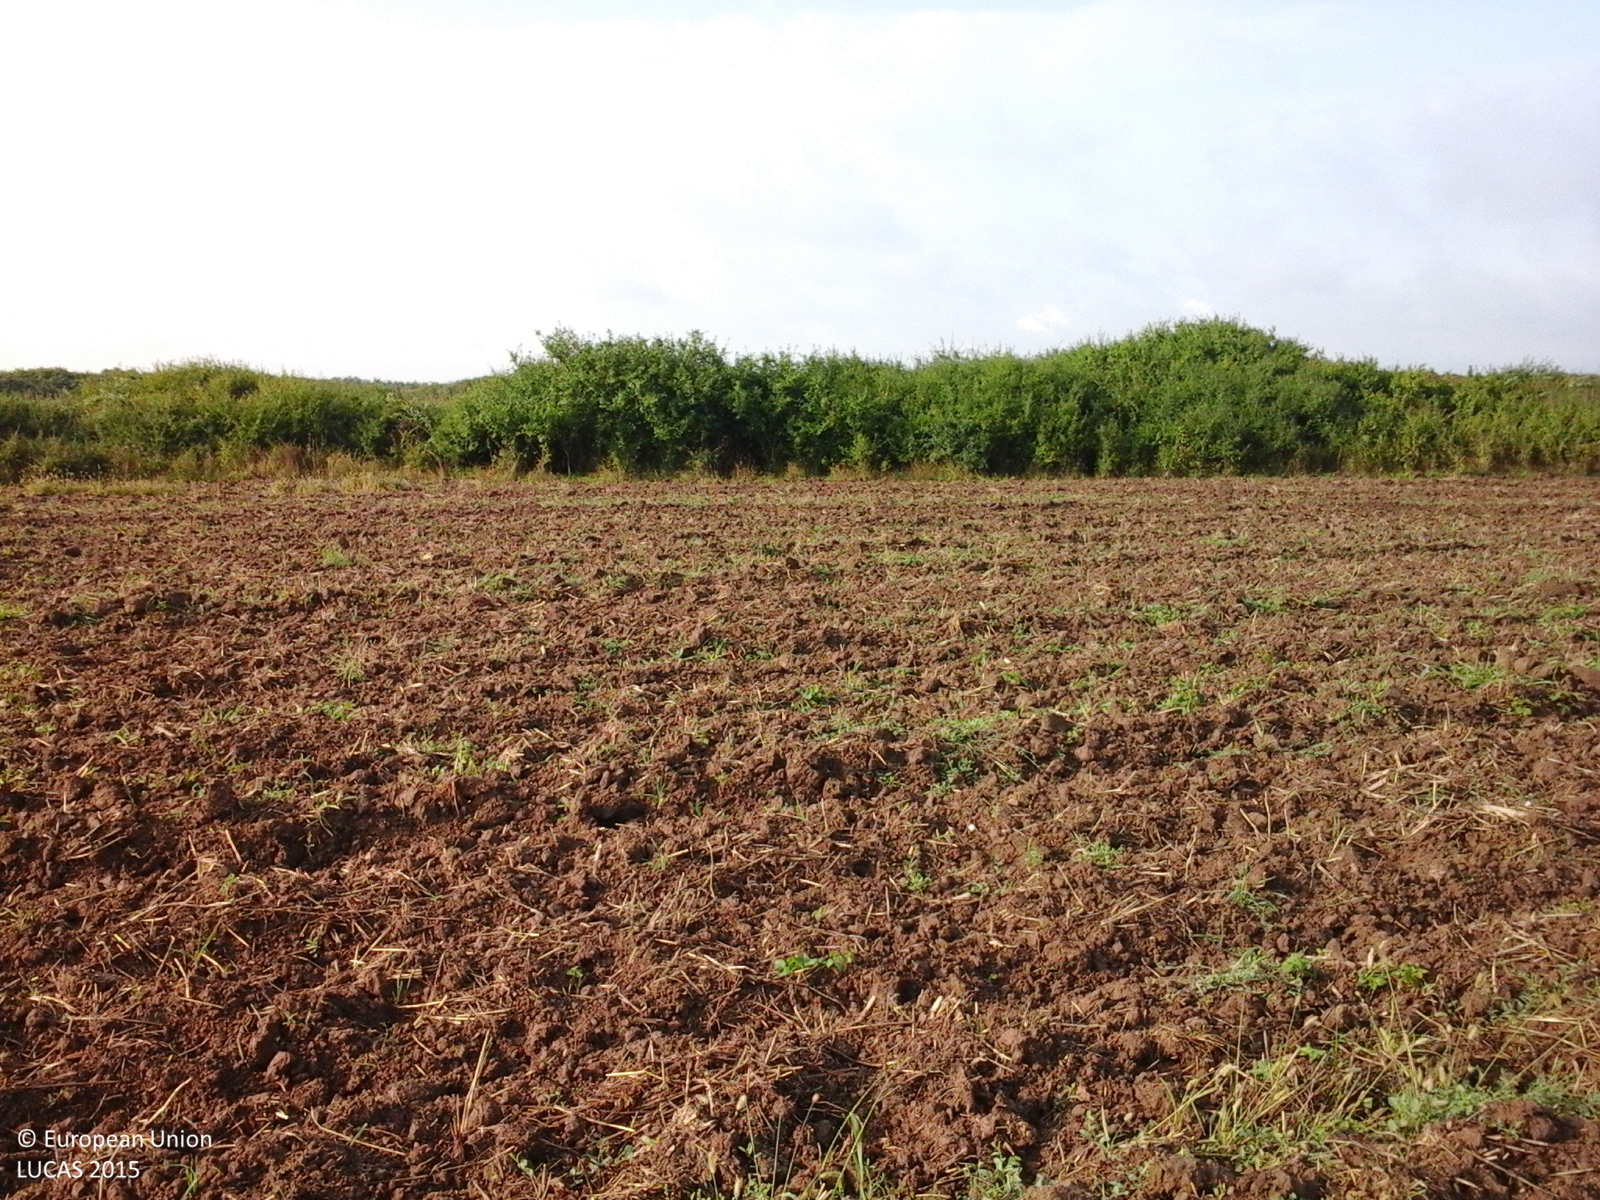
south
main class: Cropland
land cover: Common wheat
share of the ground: < 10 %
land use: Agriculture (excluding fallow land and kitchen gardens)
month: September
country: RO
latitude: 46.8113
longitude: 21.7455
